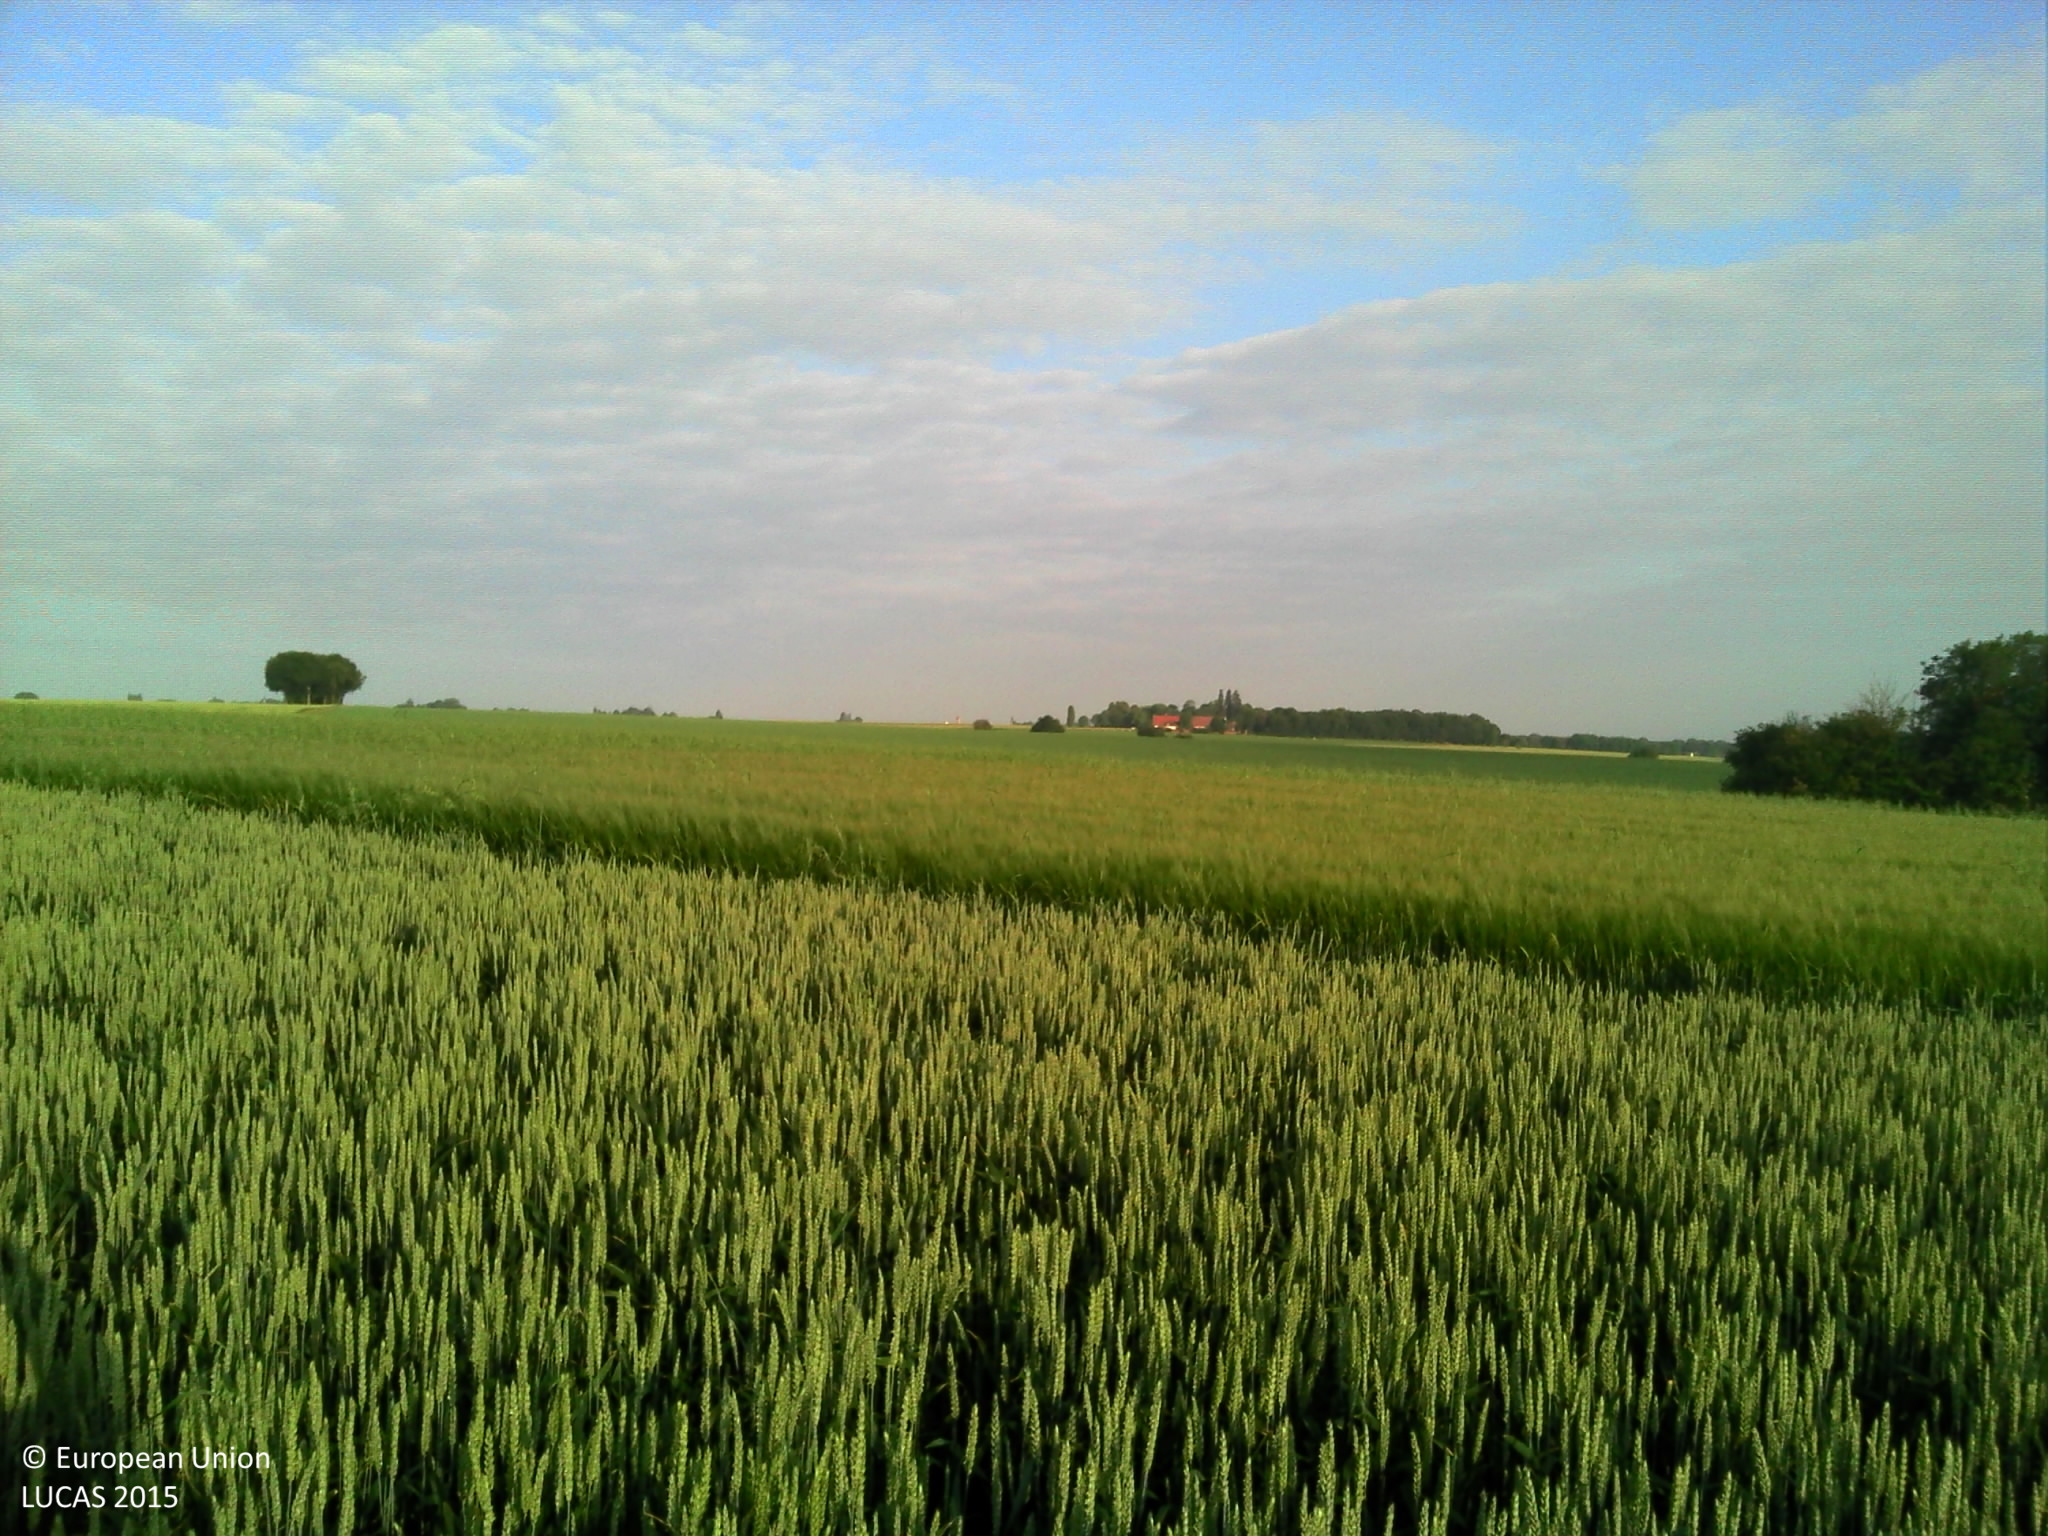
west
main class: Cropland
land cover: Common wheat
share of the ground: > 75 %
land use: Agriculture (excluding fallow land and kitchen gardens)
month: June
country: FR
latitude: 49.4208
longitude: 2.6134
